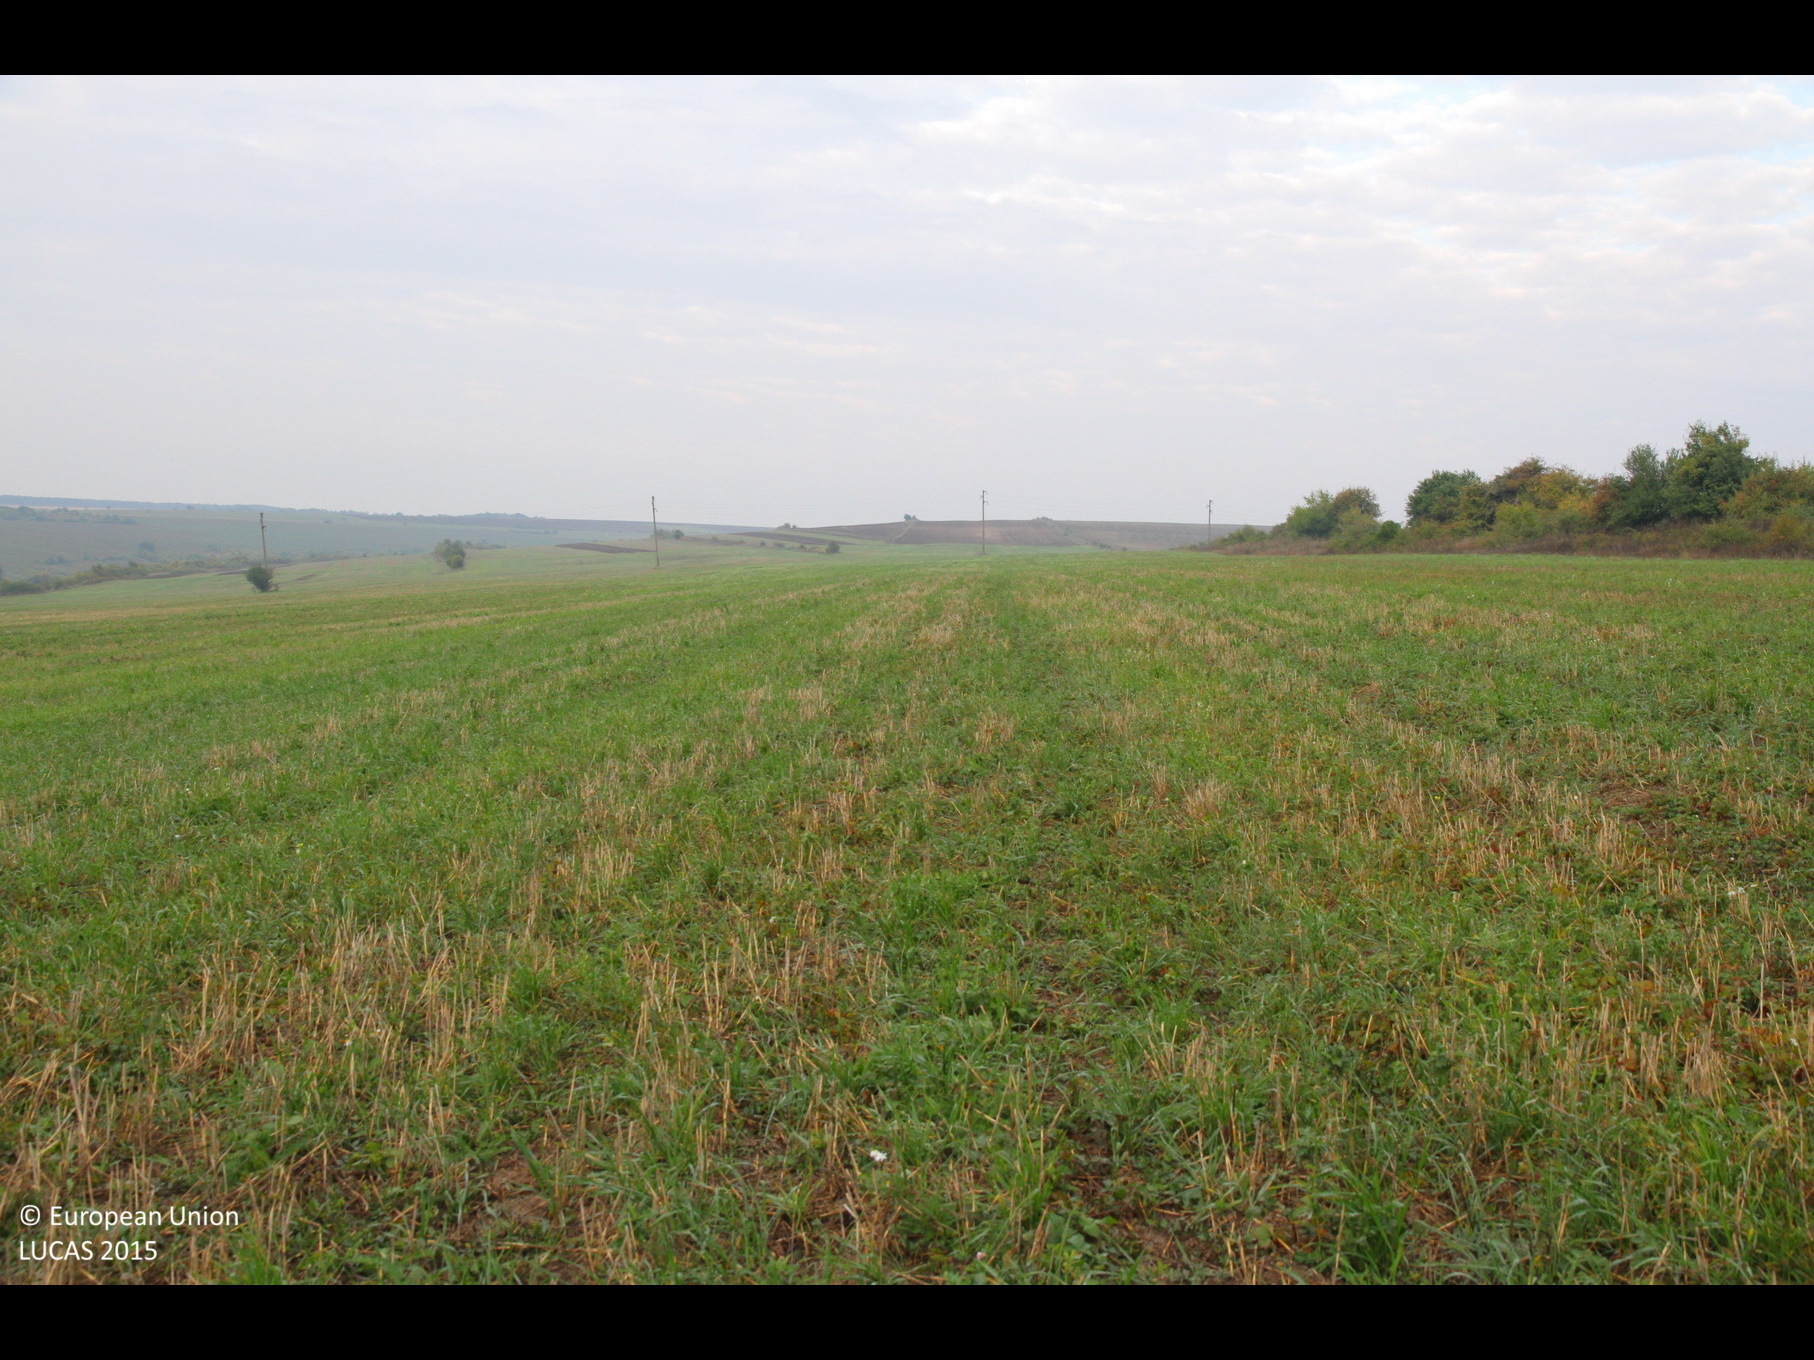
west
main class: Cropland
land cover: Common wheat
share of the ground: < 10 %
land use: Agriculture (excluding fallow land and kitchen gardens)
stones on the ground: < 10 %
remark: Harvested field
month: October
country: BG
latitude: 43.4881
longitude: 26.9954
